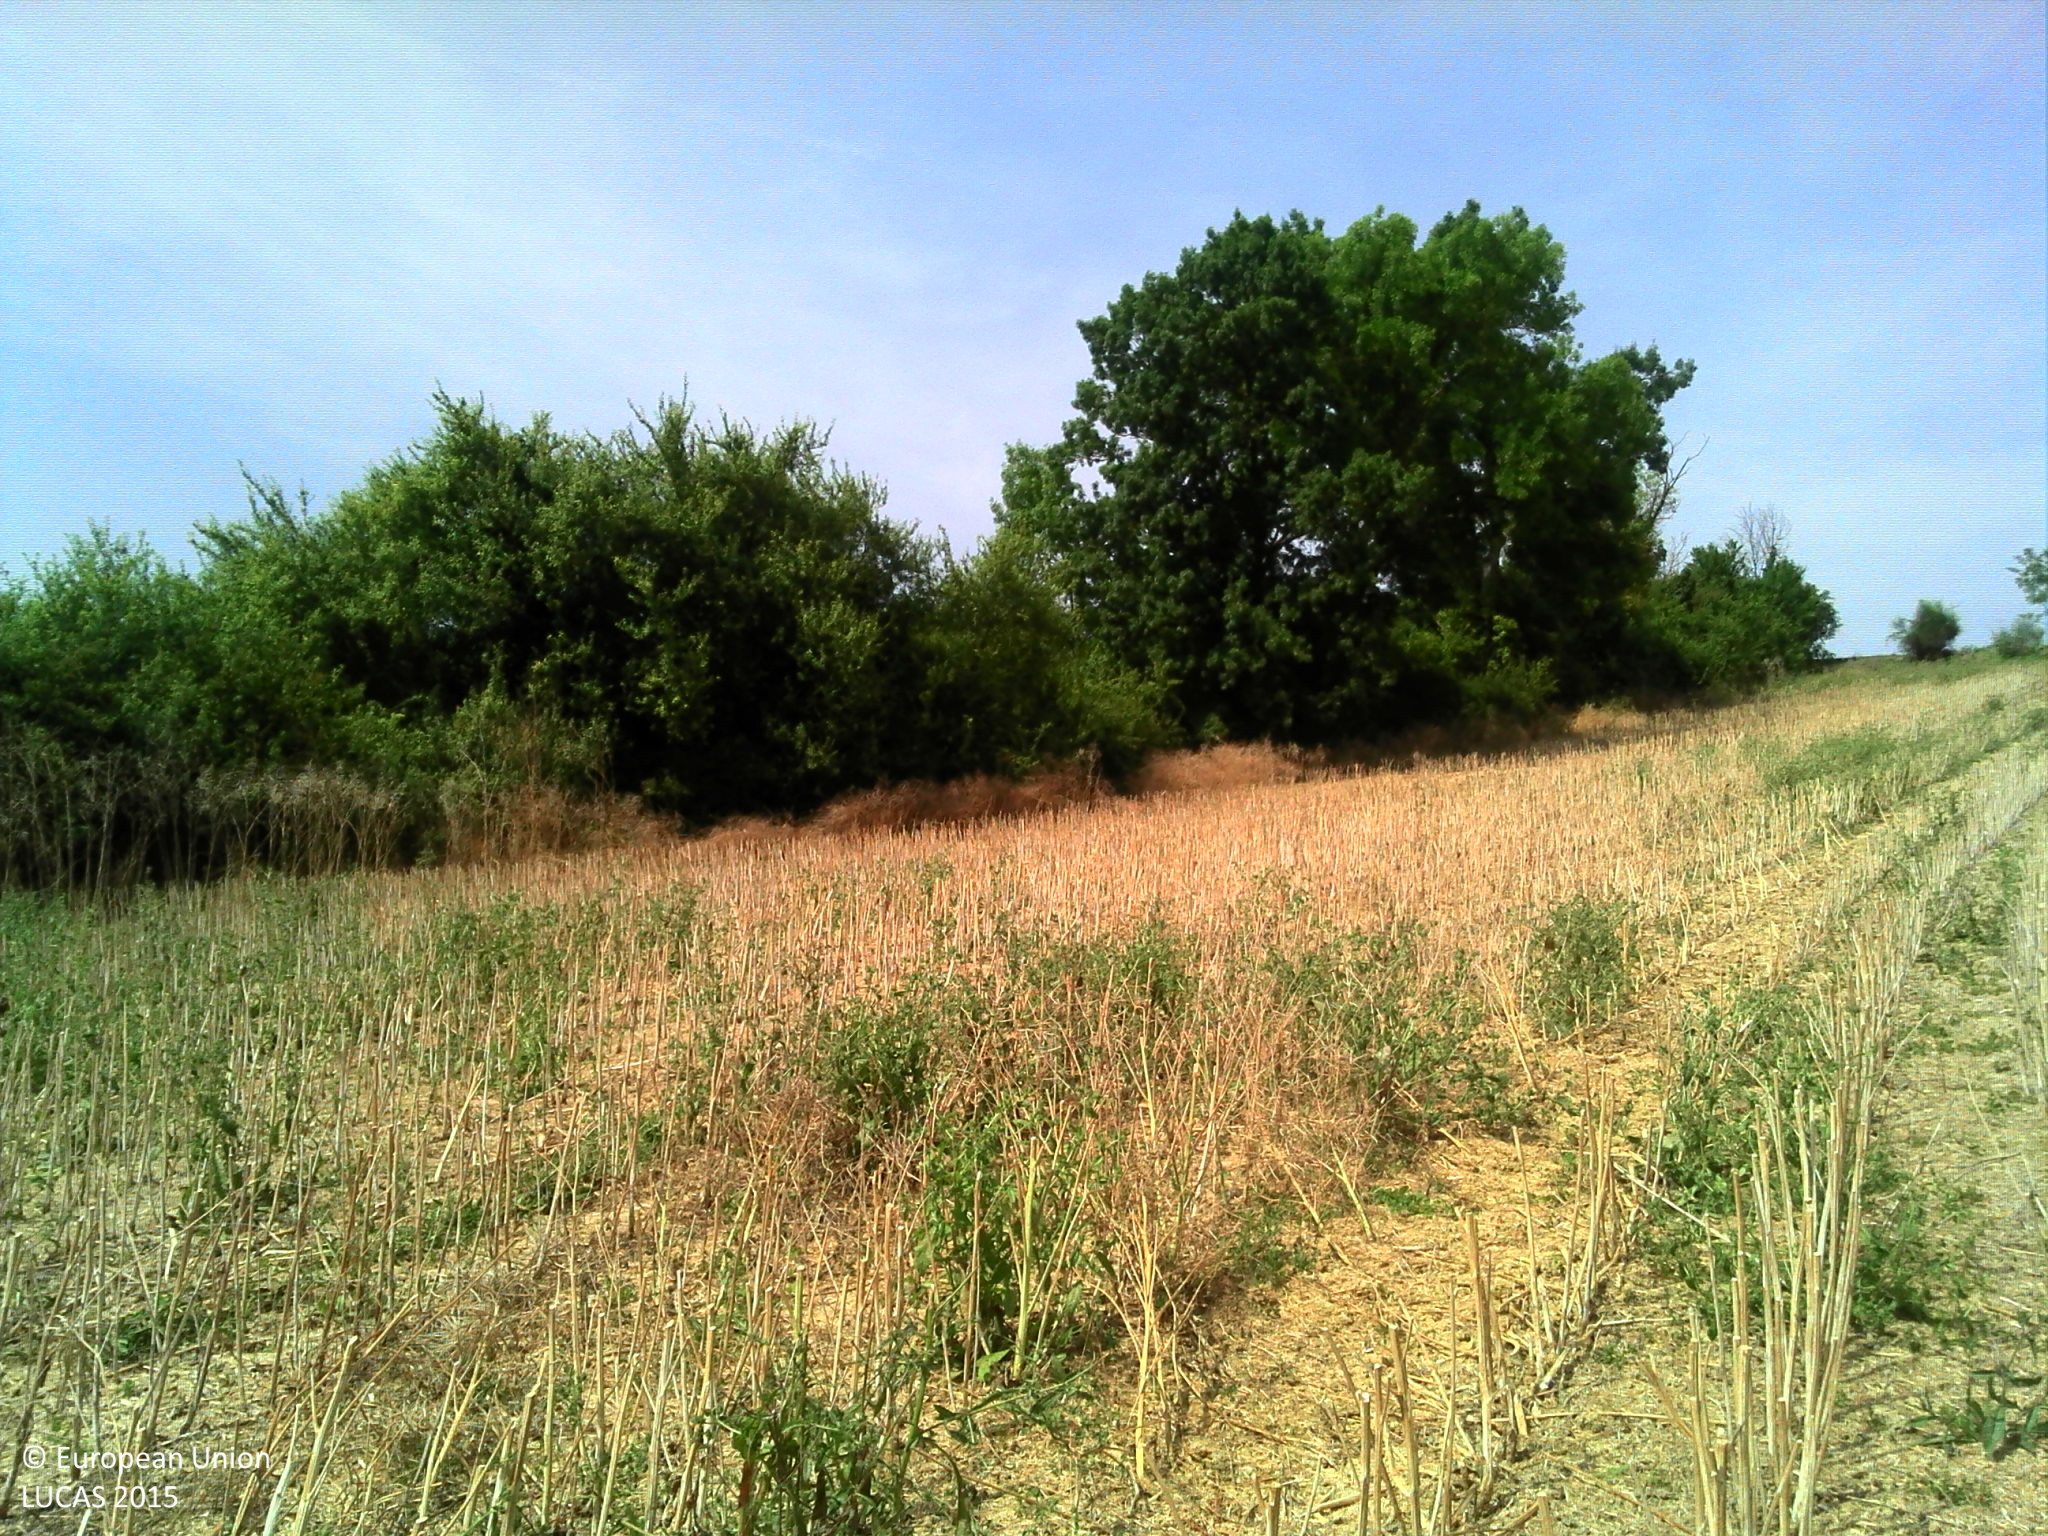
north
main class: Cropland
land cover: Rape and turnip rape
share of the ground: 10 - 25 %
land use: Agriculture (excluding fallow land and kitchen gardens)
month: July
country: FR
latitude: 43.6449
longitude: 0.9374
